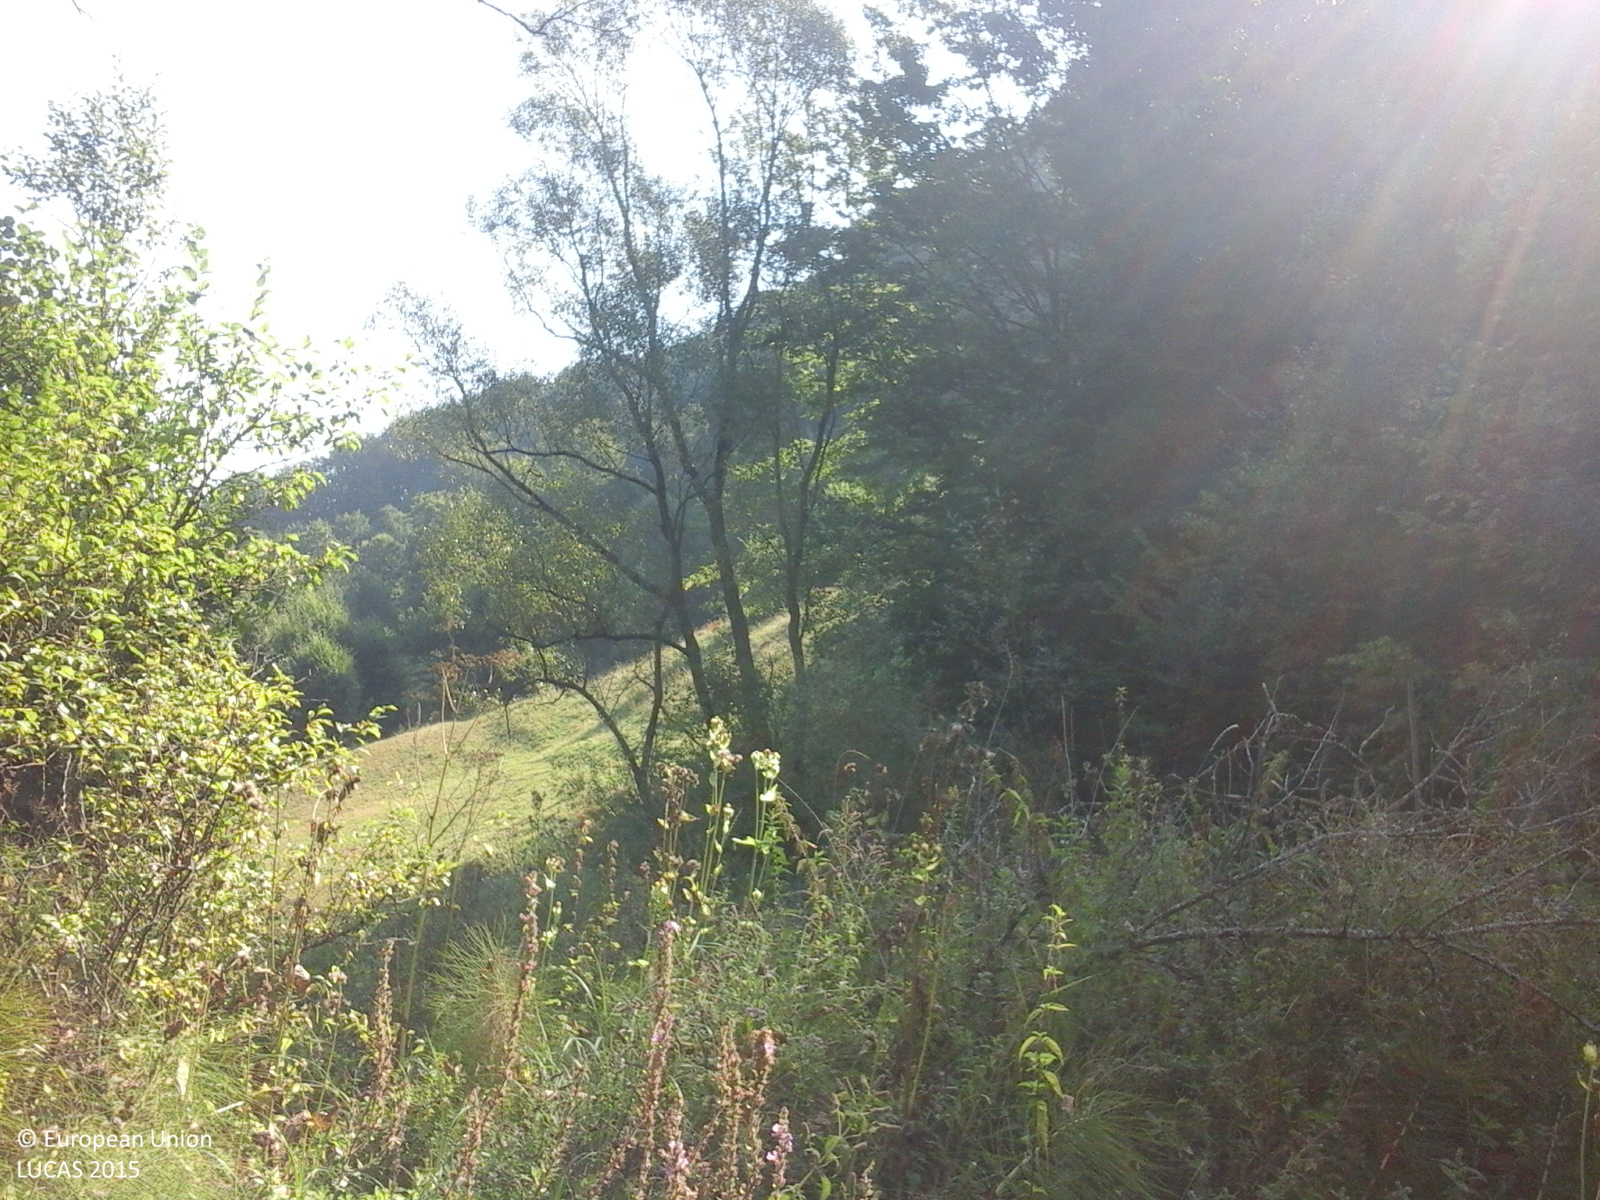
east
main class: Grassland
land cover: Grassland with sparse tree/shrub cover
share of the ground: > 75 %
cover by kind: herbaceous plants 85 %, shrubs 10 %, broadleaved forest trees 5 %
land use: Fallow land
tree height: < 5 m
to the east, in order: Grassland with sparse tree/shrub cover; Inland fresh running water; Grassland with sparse tree/shrub cover; Grassland without tree/shrub cover; Broadleaved woodland; Grassland without tree/shrub cover; Inland fresh running water; Broadleaved woodland; Grassland without tree/shrub cover; Broadleaved woodland; Grassland with sparse tree/shrub cover; Broadleaved woodland
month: September
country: RO
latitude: 47.3662
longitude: 24.3778
